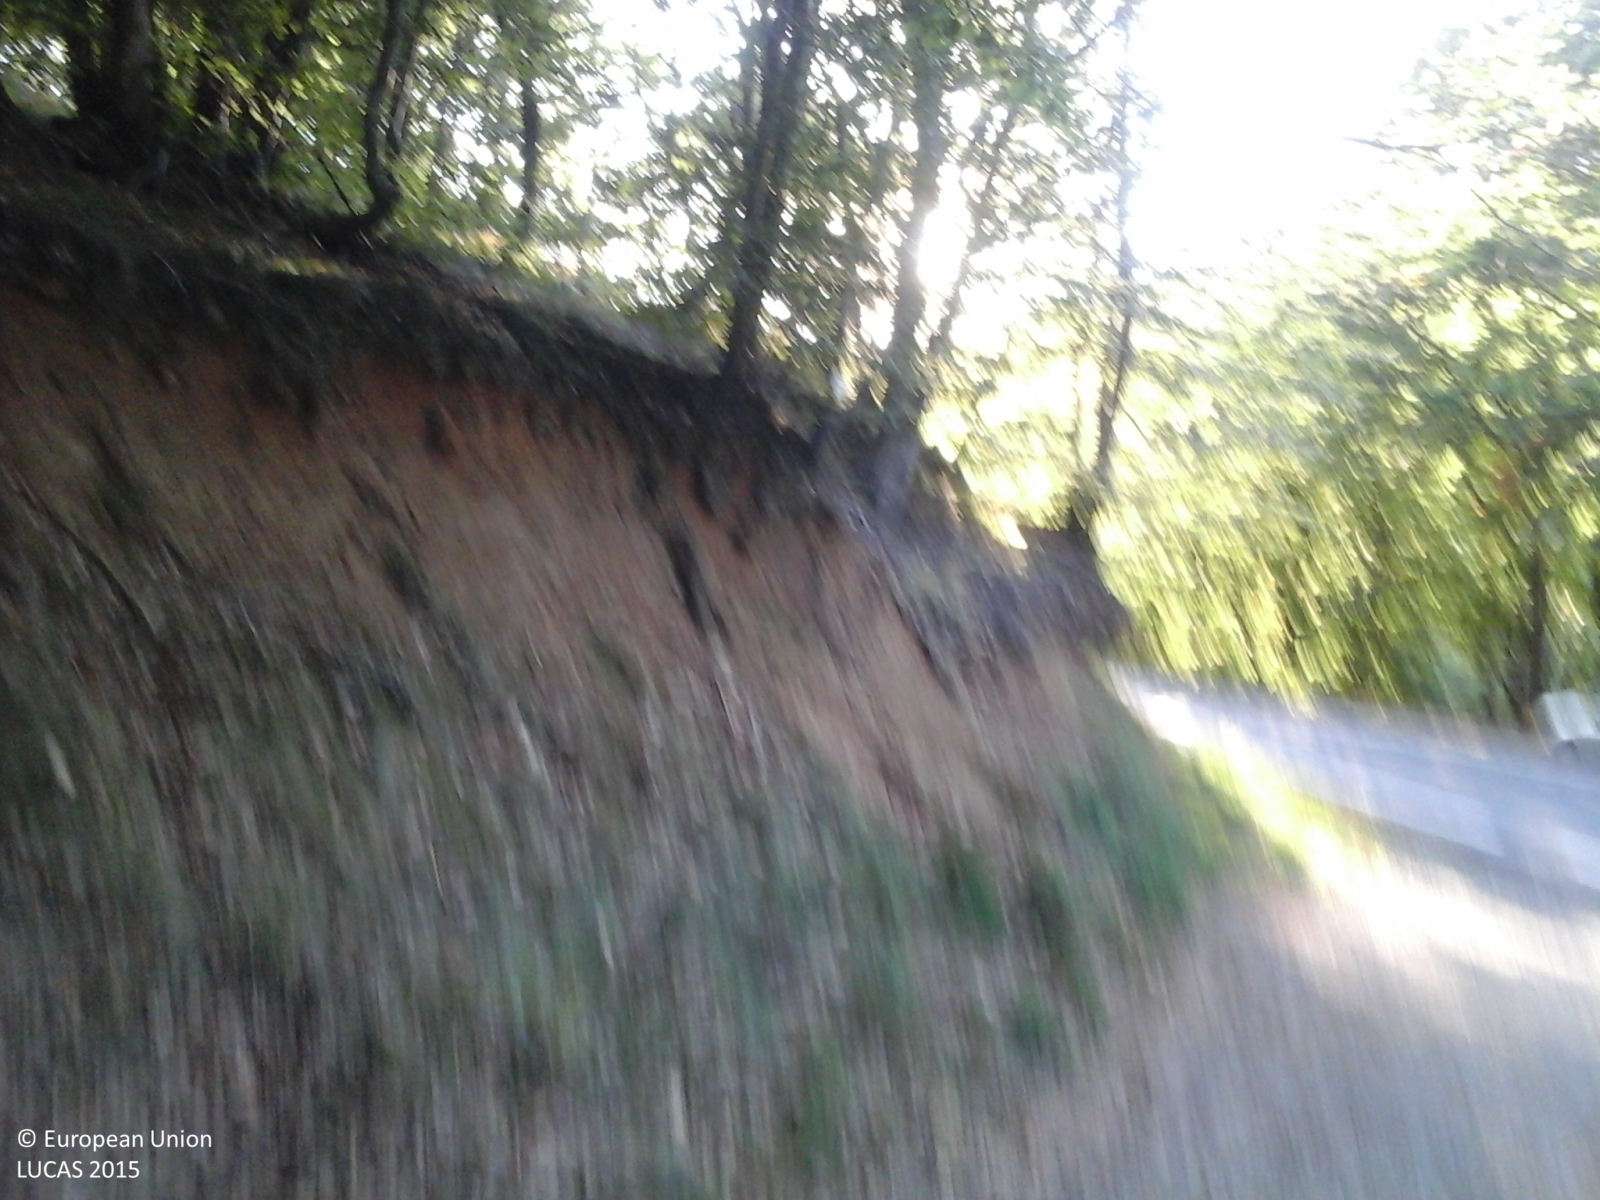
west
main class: Woodland
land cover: Broadleaved woodland
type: beech forest
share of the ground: > 75 %
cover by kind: broadleaved forest trees 100 %
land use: Semi-natural and natural areas not in use
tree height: > 5 m
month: September
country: IT
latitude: 44.3929
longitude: 8.4342
